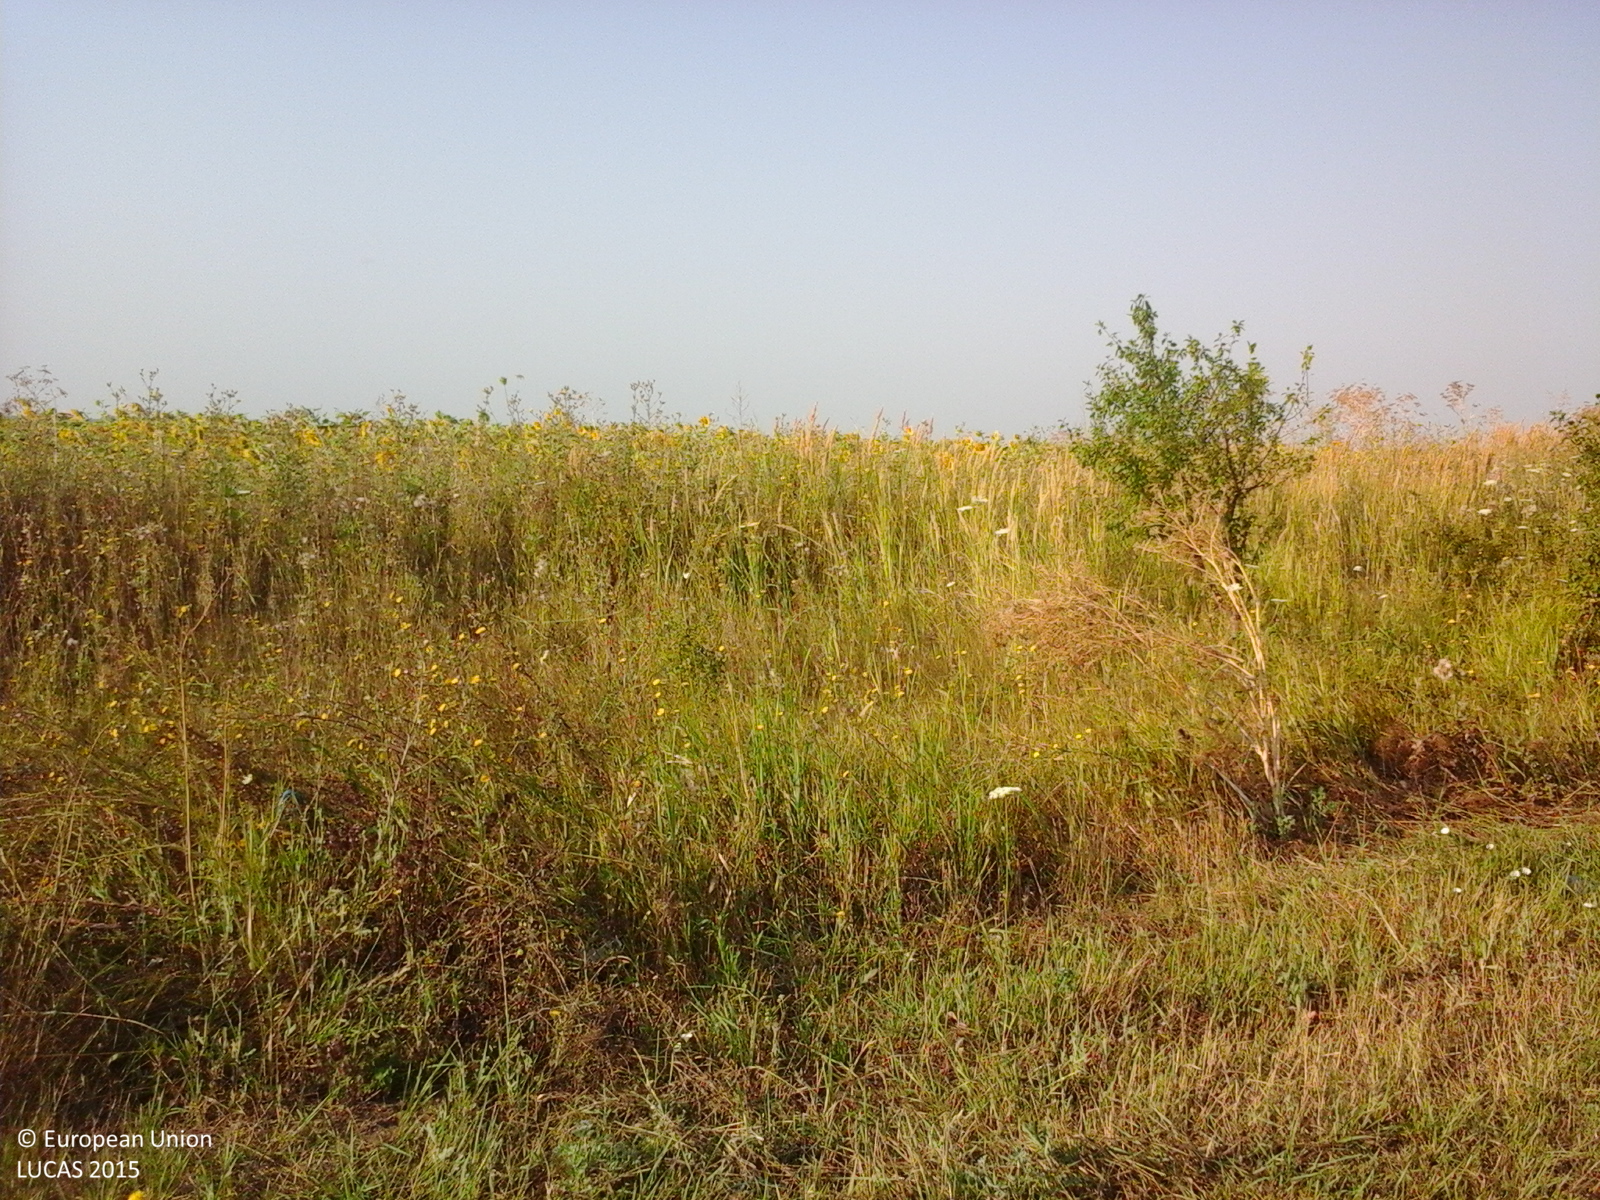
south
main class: Cropland
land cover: Lucerne
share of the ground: 50 - 75 %
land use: Agriculture (excluding fallow land and kitchen gardens)
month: July
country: RO
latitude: 45.5681
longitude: 27.5429
